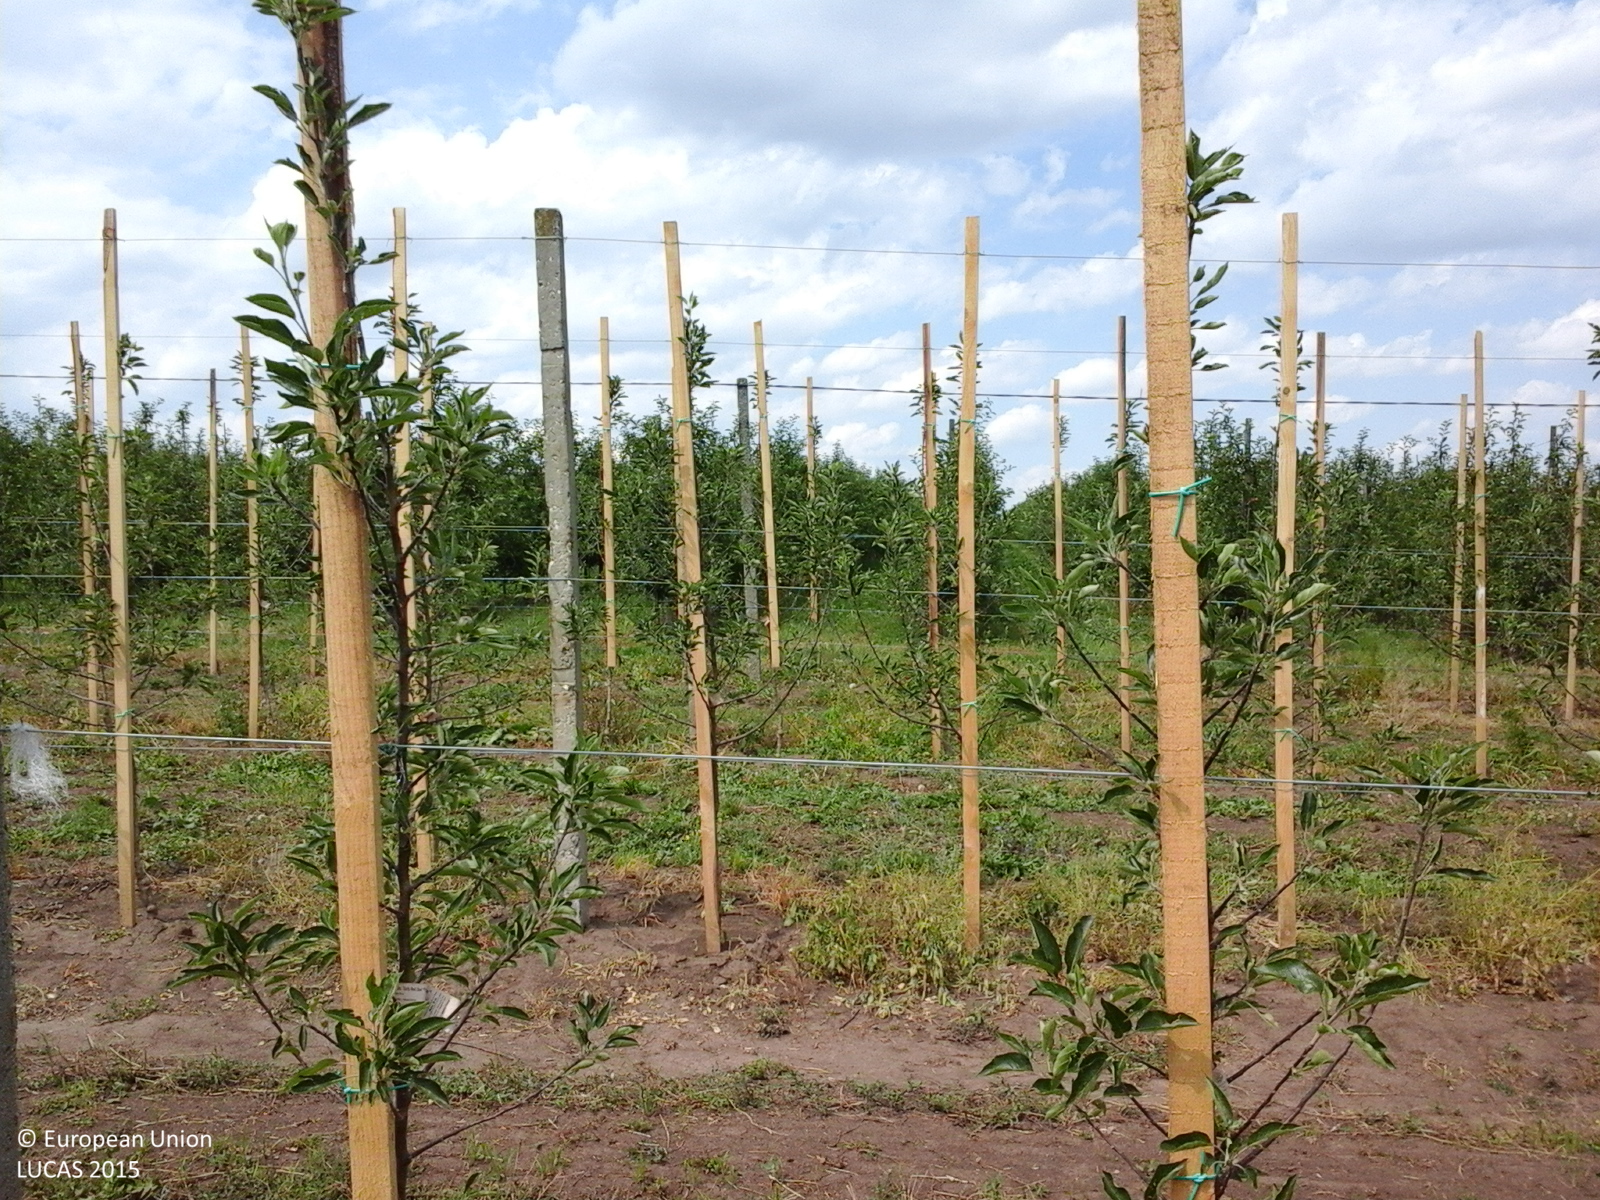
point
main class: Cropland
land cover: Apple fruit
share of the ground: 10 - 25 %
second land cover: Grassland without tree/shrub cover
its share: 50 - 75 %
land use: Agriculture (excluding fallow land and kitchen gardens)
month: June
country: RO
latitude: 47.4964
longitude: 26.2911
